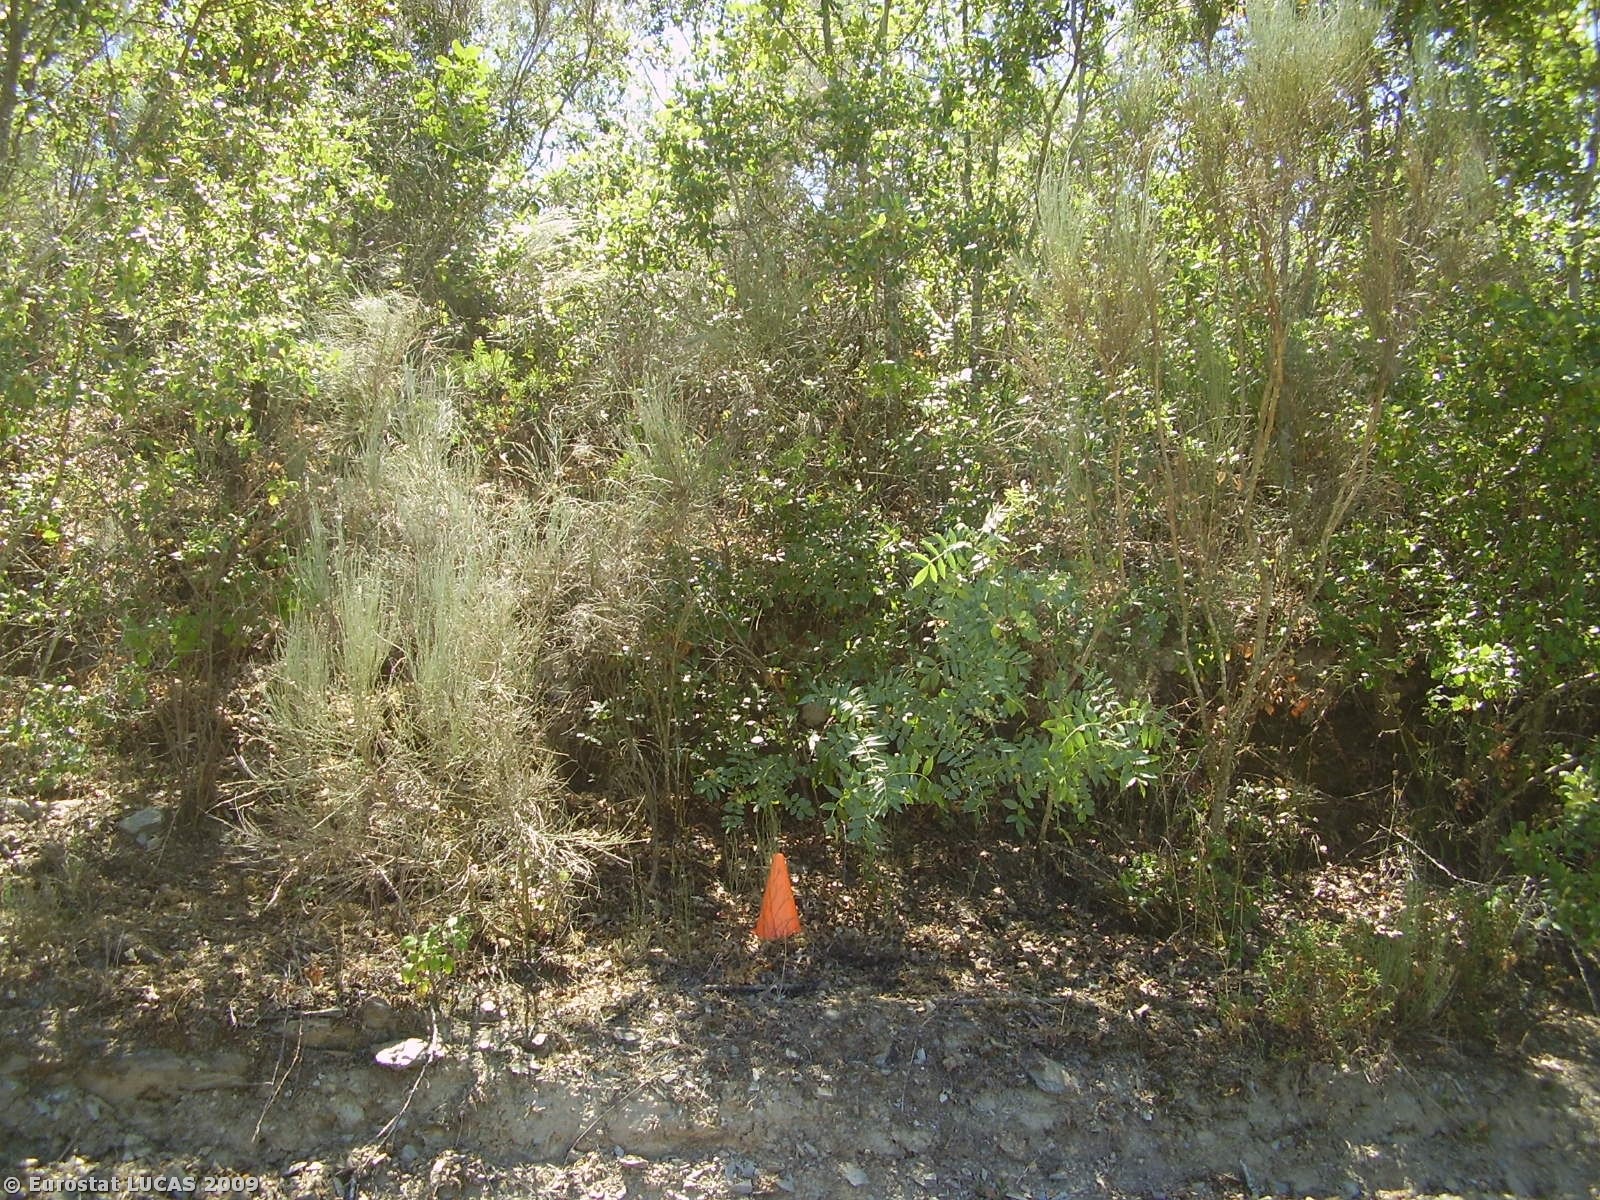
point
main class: Cropland
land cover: Olive groves
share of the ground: 50 - 75 %
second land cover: Bare land
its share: > 75 %
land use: Agriculture (excluding fallow land and kitchen gardens)
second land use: Fallow land
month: August
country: PT
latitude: 41.1985
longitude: -6.7137
